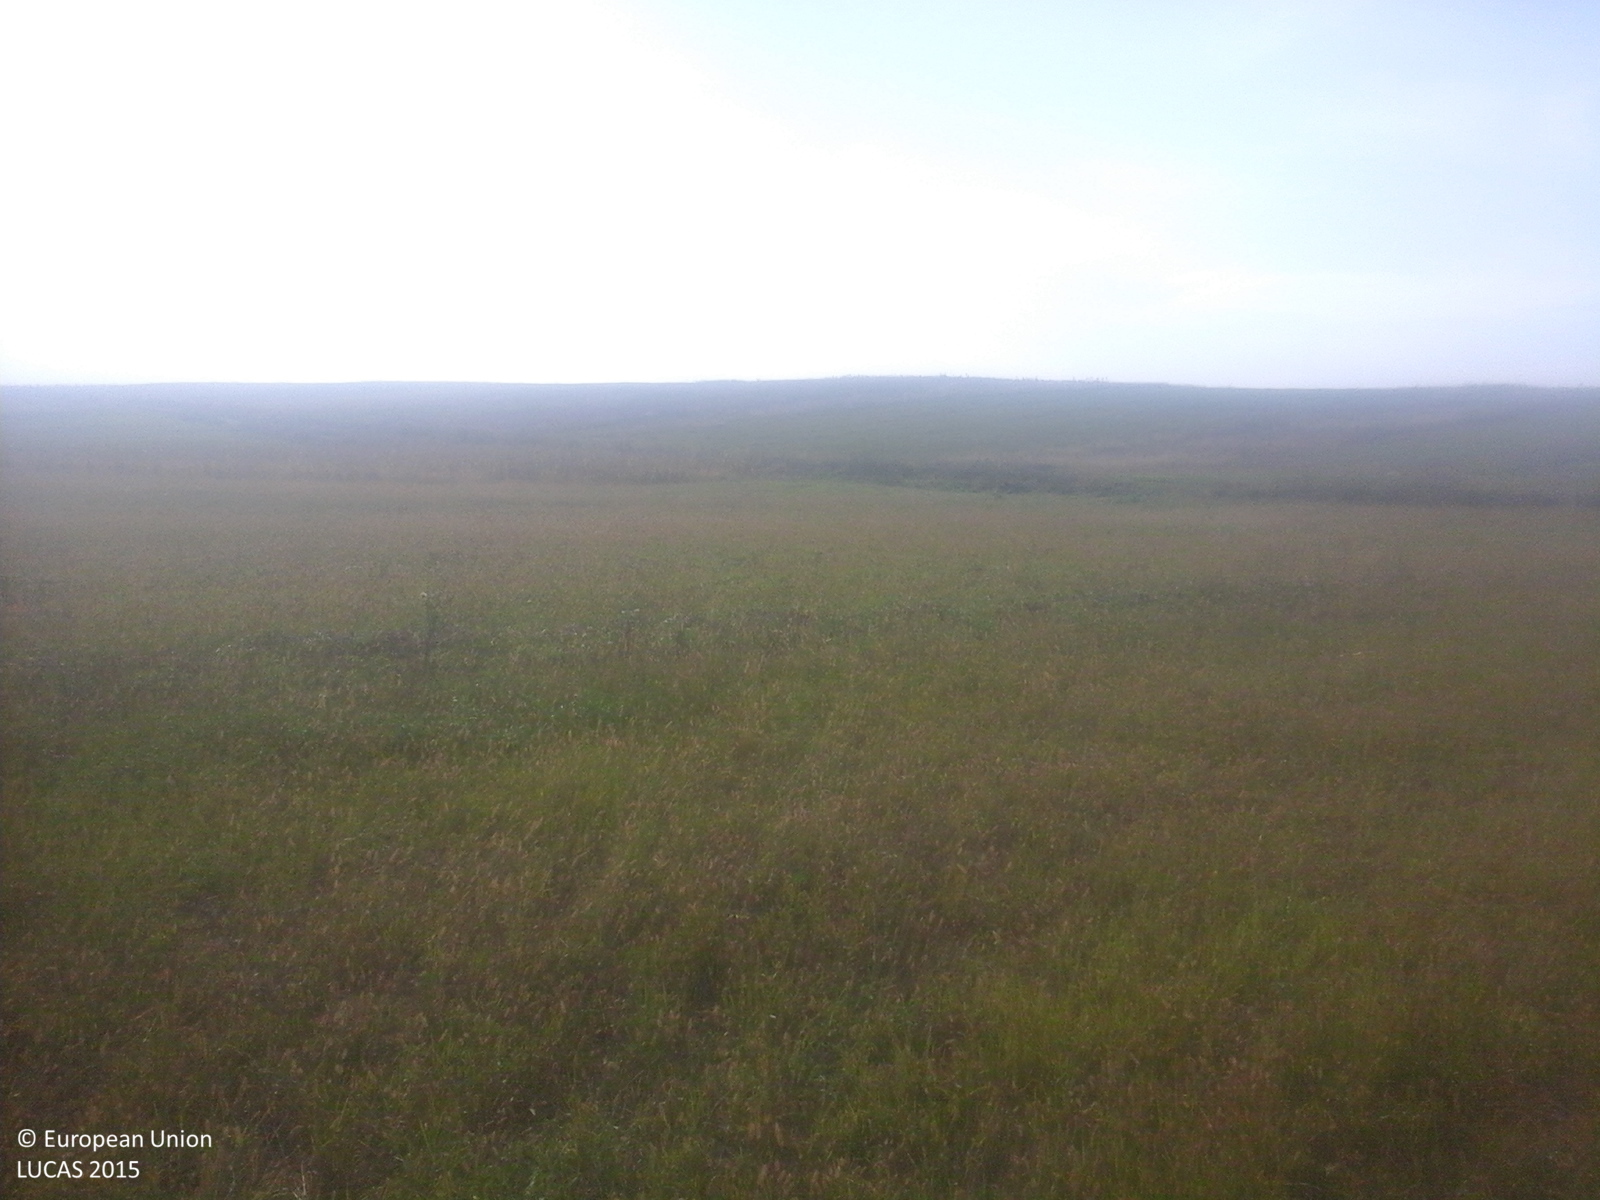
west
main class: Cropland
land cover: Temporary grasslands
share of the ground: > 75 %
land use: Agriculture (excluding fallow land and kitchen gardens)
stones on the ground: < 10 %
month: September
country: RO
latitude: 47.0827
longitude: 23.1712
